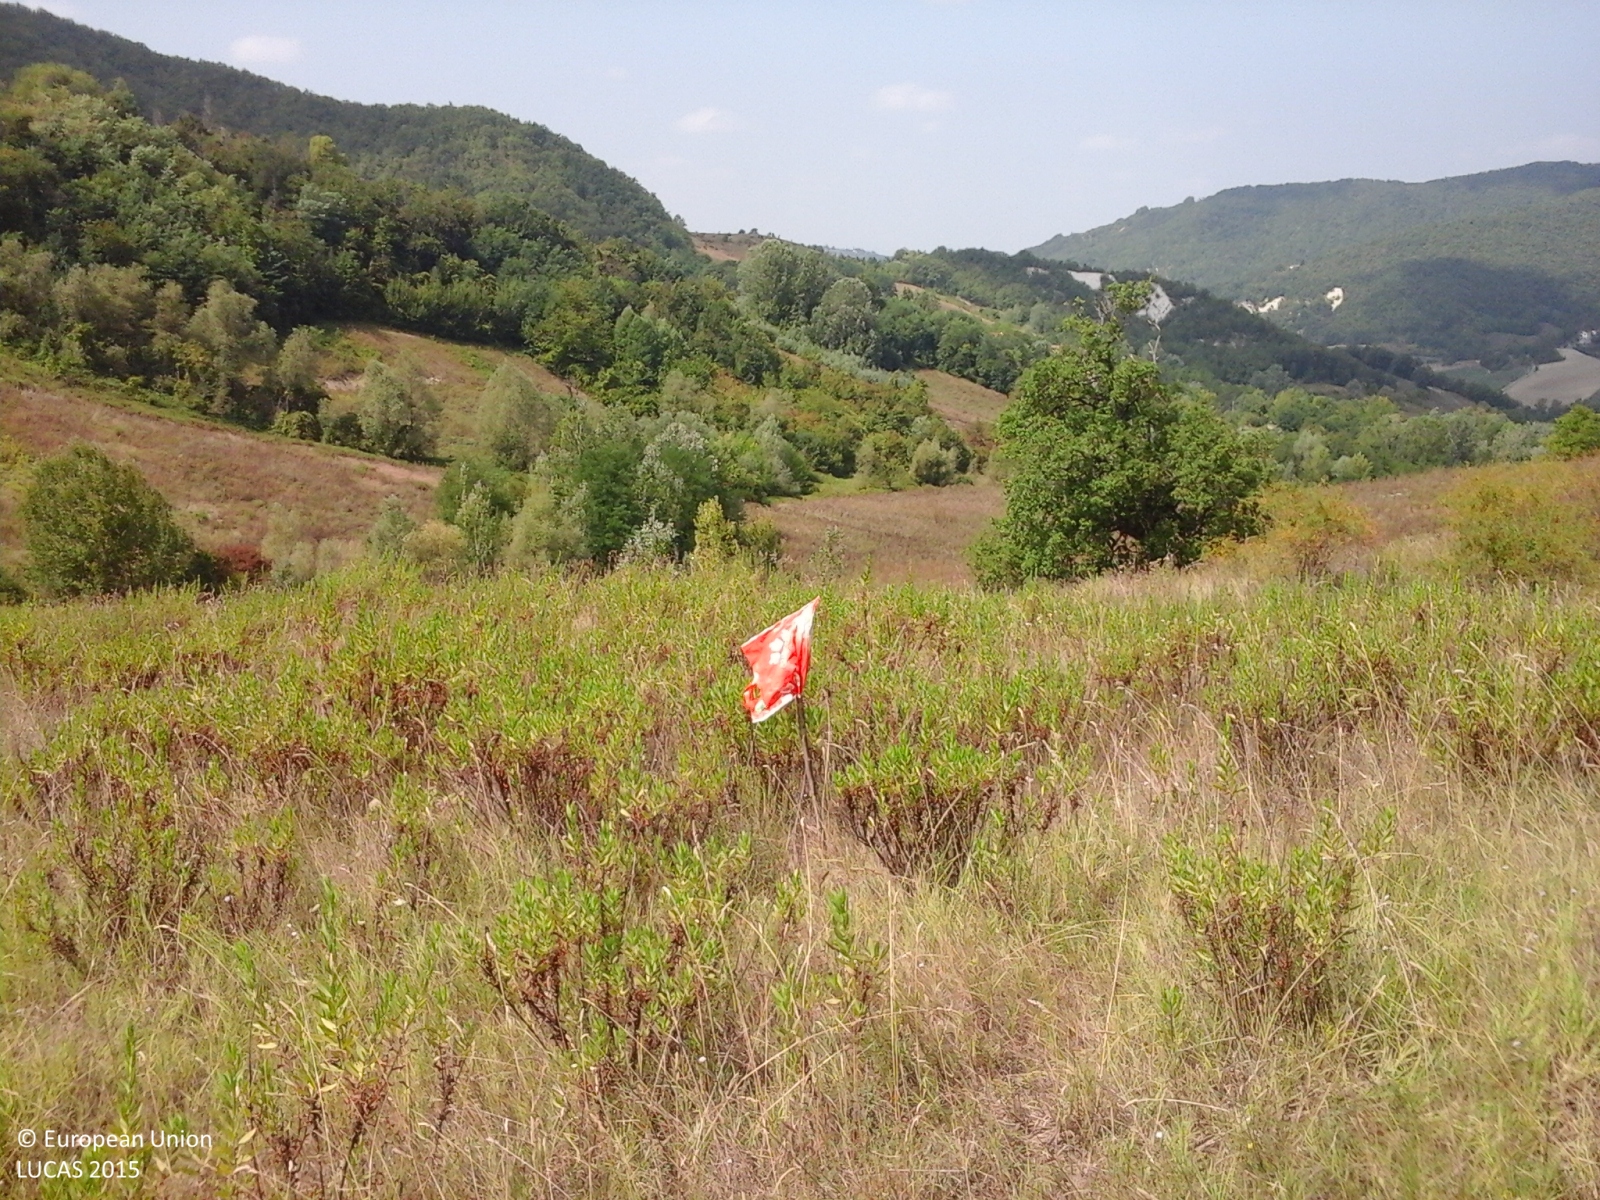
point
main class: Grassland
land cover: Grassland without tree/shrub cover
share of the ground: > 75 %
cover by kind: herbaceous plants 100 %
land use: Semi-natural and natural areas not in use
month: August
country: IT
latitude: 44.8877
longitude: 9.1029
